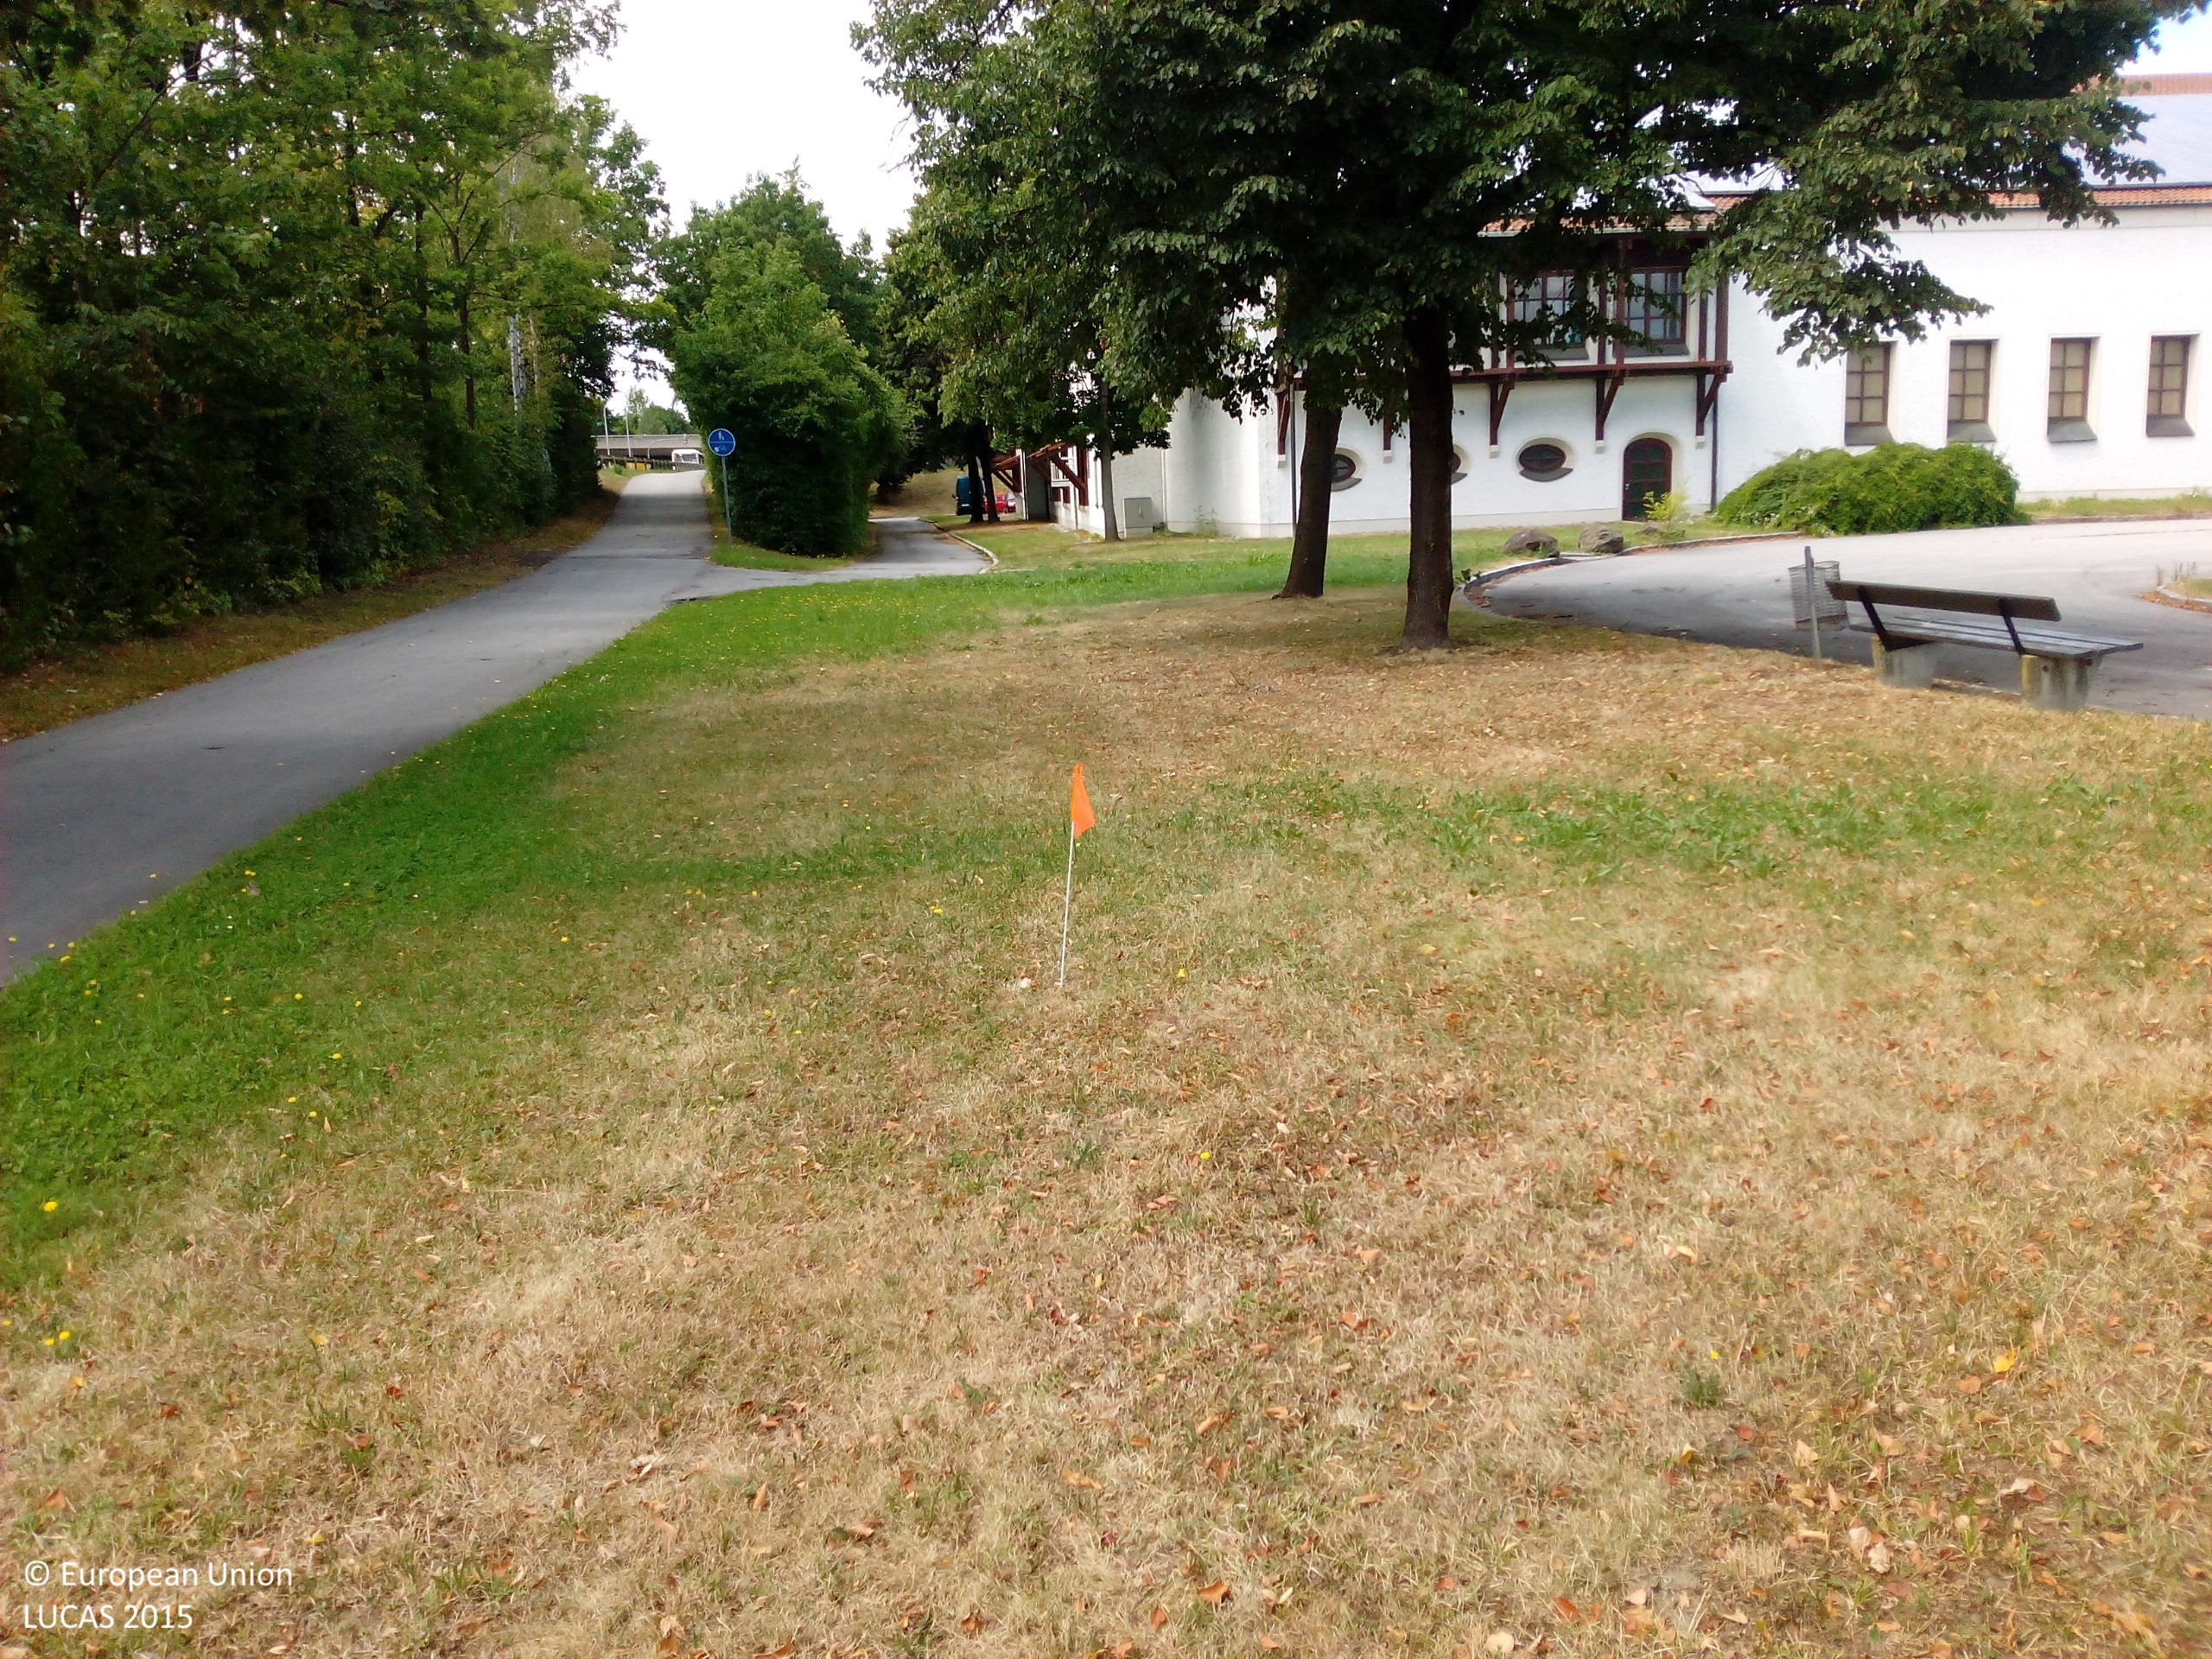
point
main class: Grassland
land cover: Grassland with sparse tree/shrub cover
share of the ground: > 75 %
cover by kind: herbaceous plants 95 %, broadleaved forest trees 5 %
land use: Community services
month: July
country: DE
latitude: 48.8321
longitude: 12.9557
